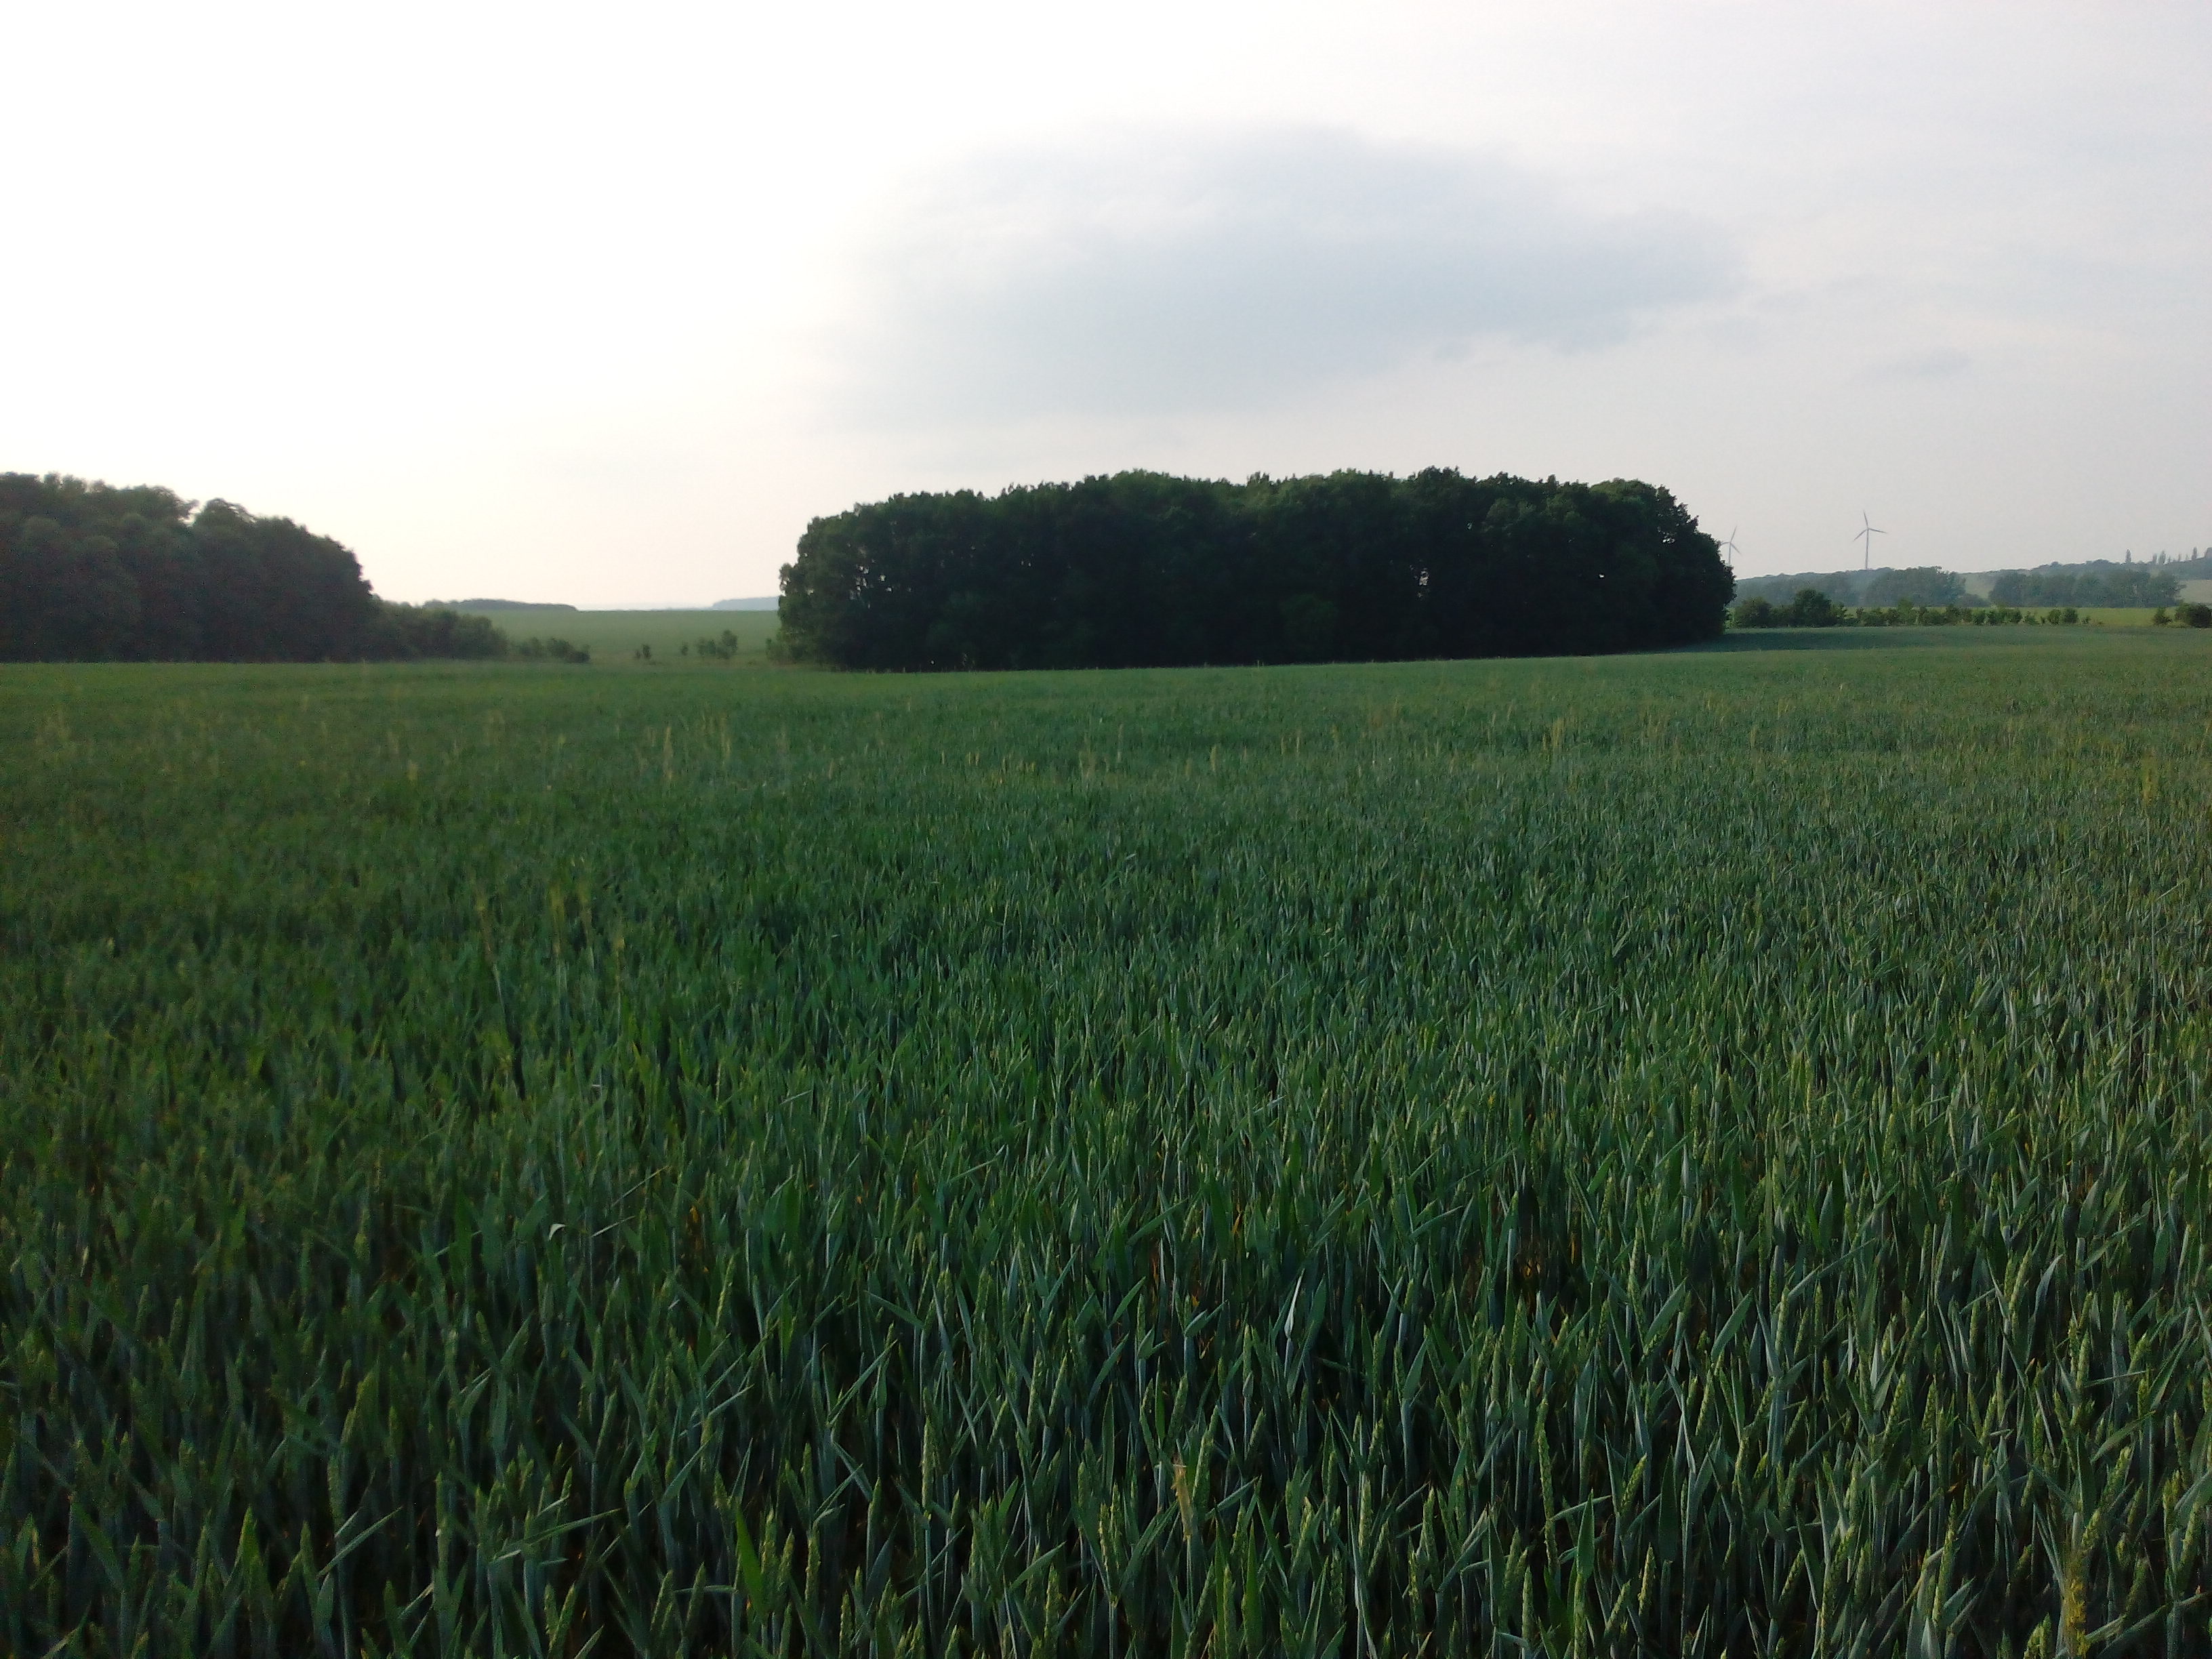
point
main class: Cropland
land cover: Common wheat
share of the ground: > 75 %
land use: Agriculture (excluding fallow land and kitchen gardens)
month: June
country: DE
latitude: 50.9376
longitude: 10.6402
